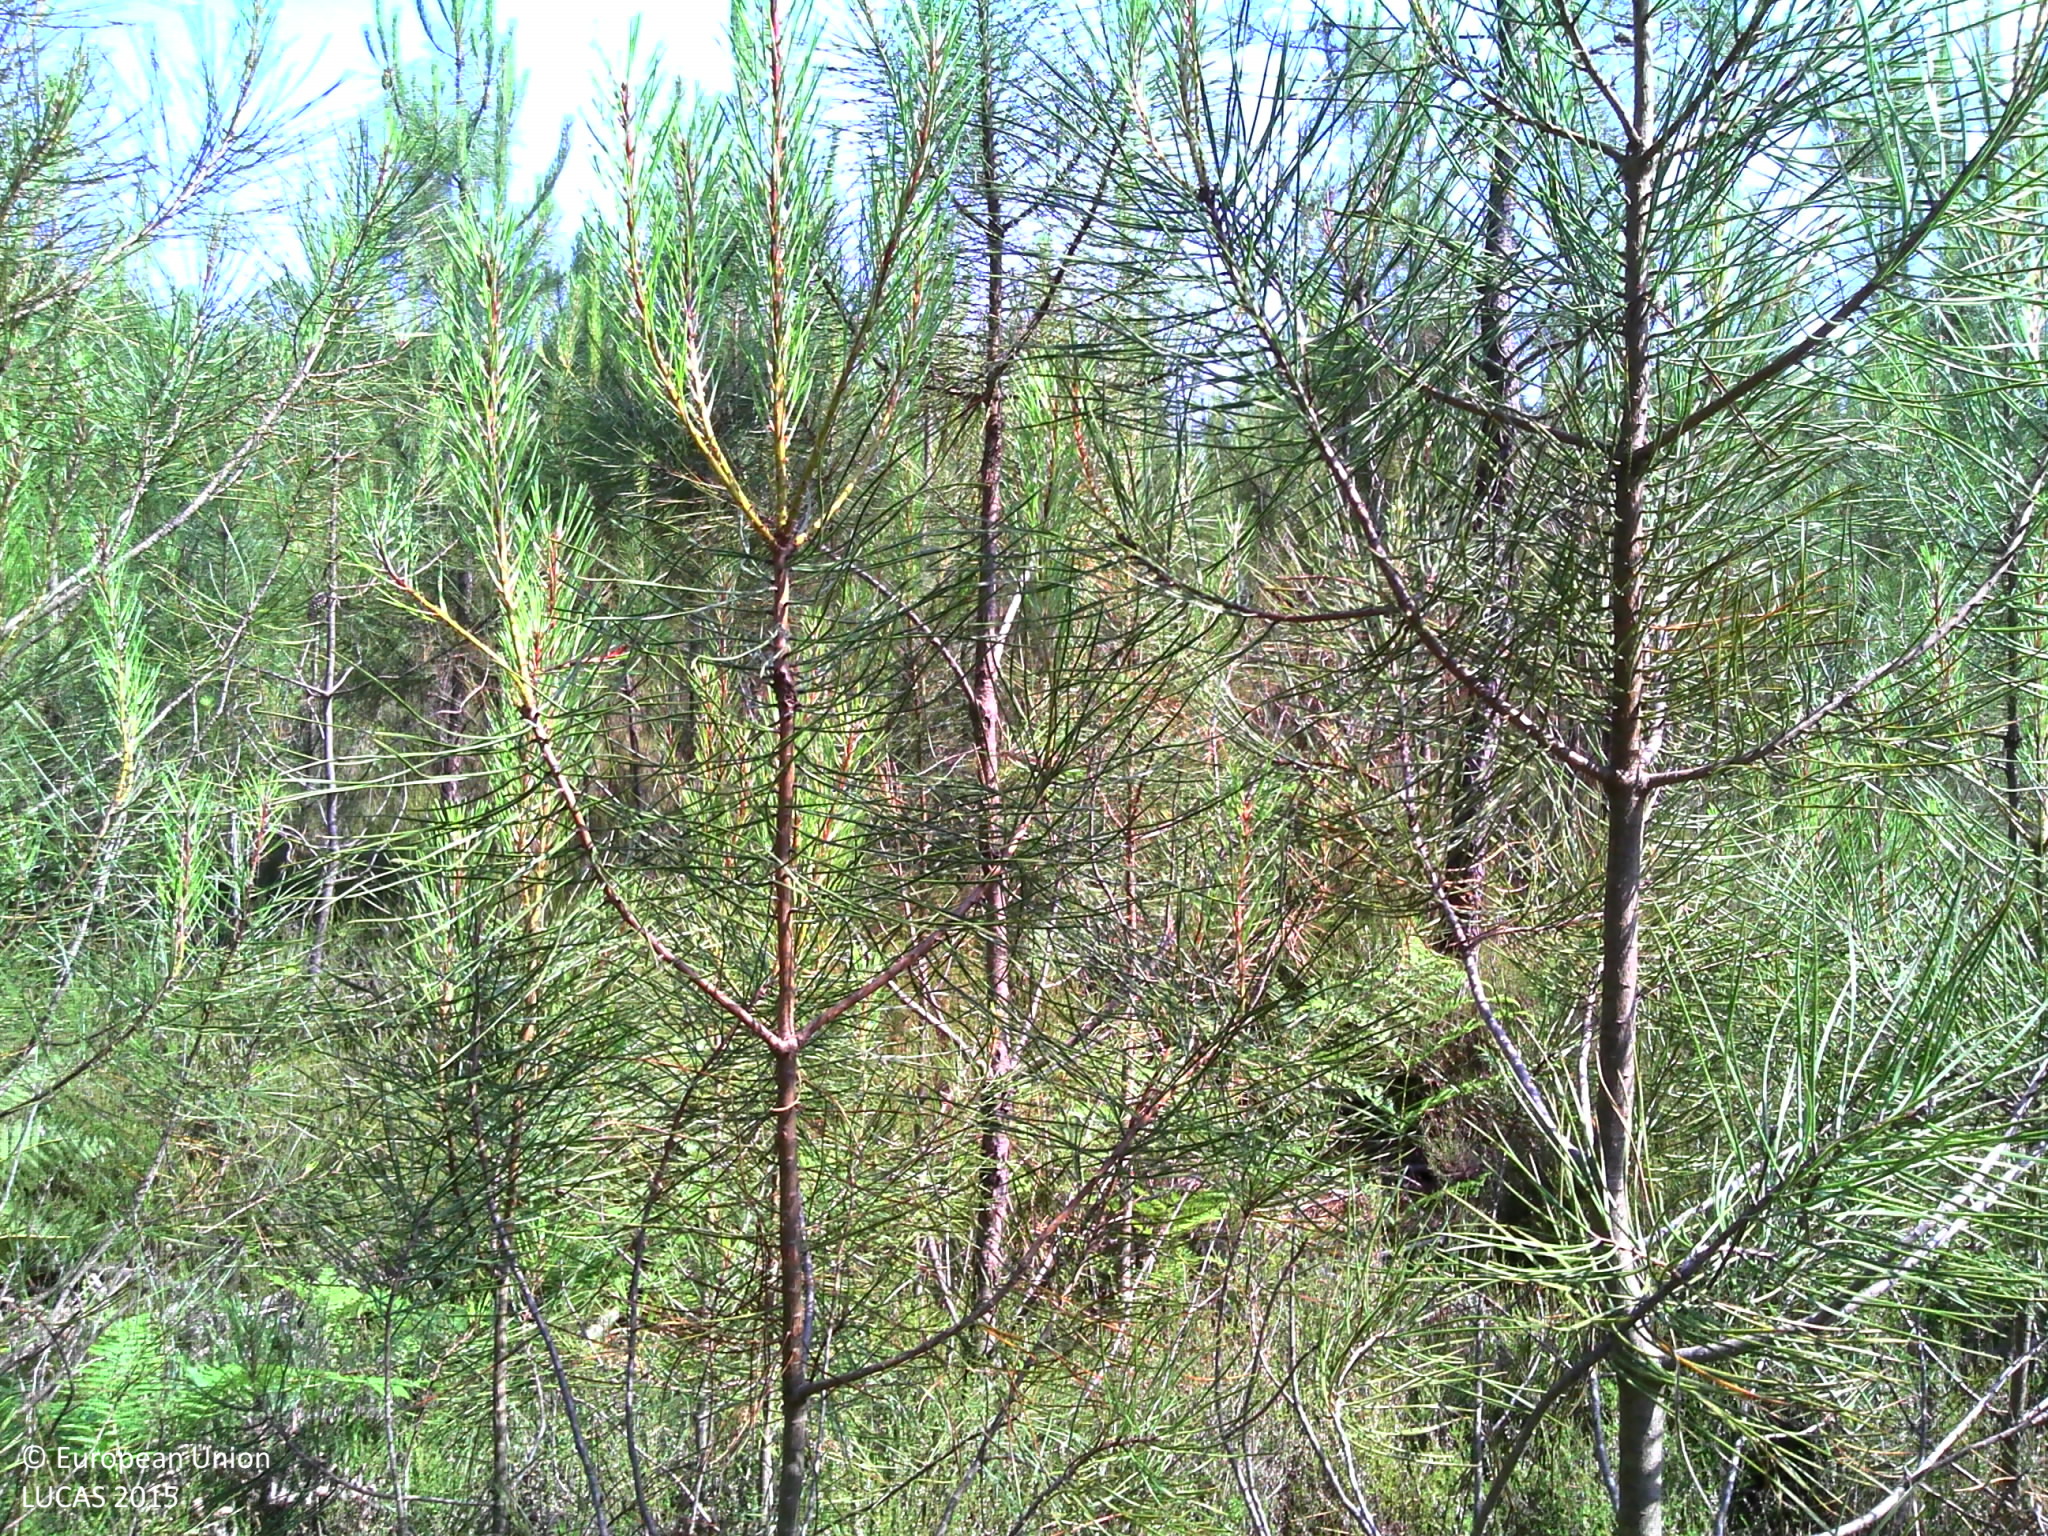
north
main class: Woodland
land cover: Pine dominated coniferous woodland
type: coniferous forest of the mediterranean region
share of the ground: > 75 %
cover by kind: coniferous forest trees 80 %, shrubs 15 %, herbaceous plants 5 %
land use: Forestry
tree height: > 5 m
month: June
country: FR
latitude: 44.0920
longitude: -0.2908
